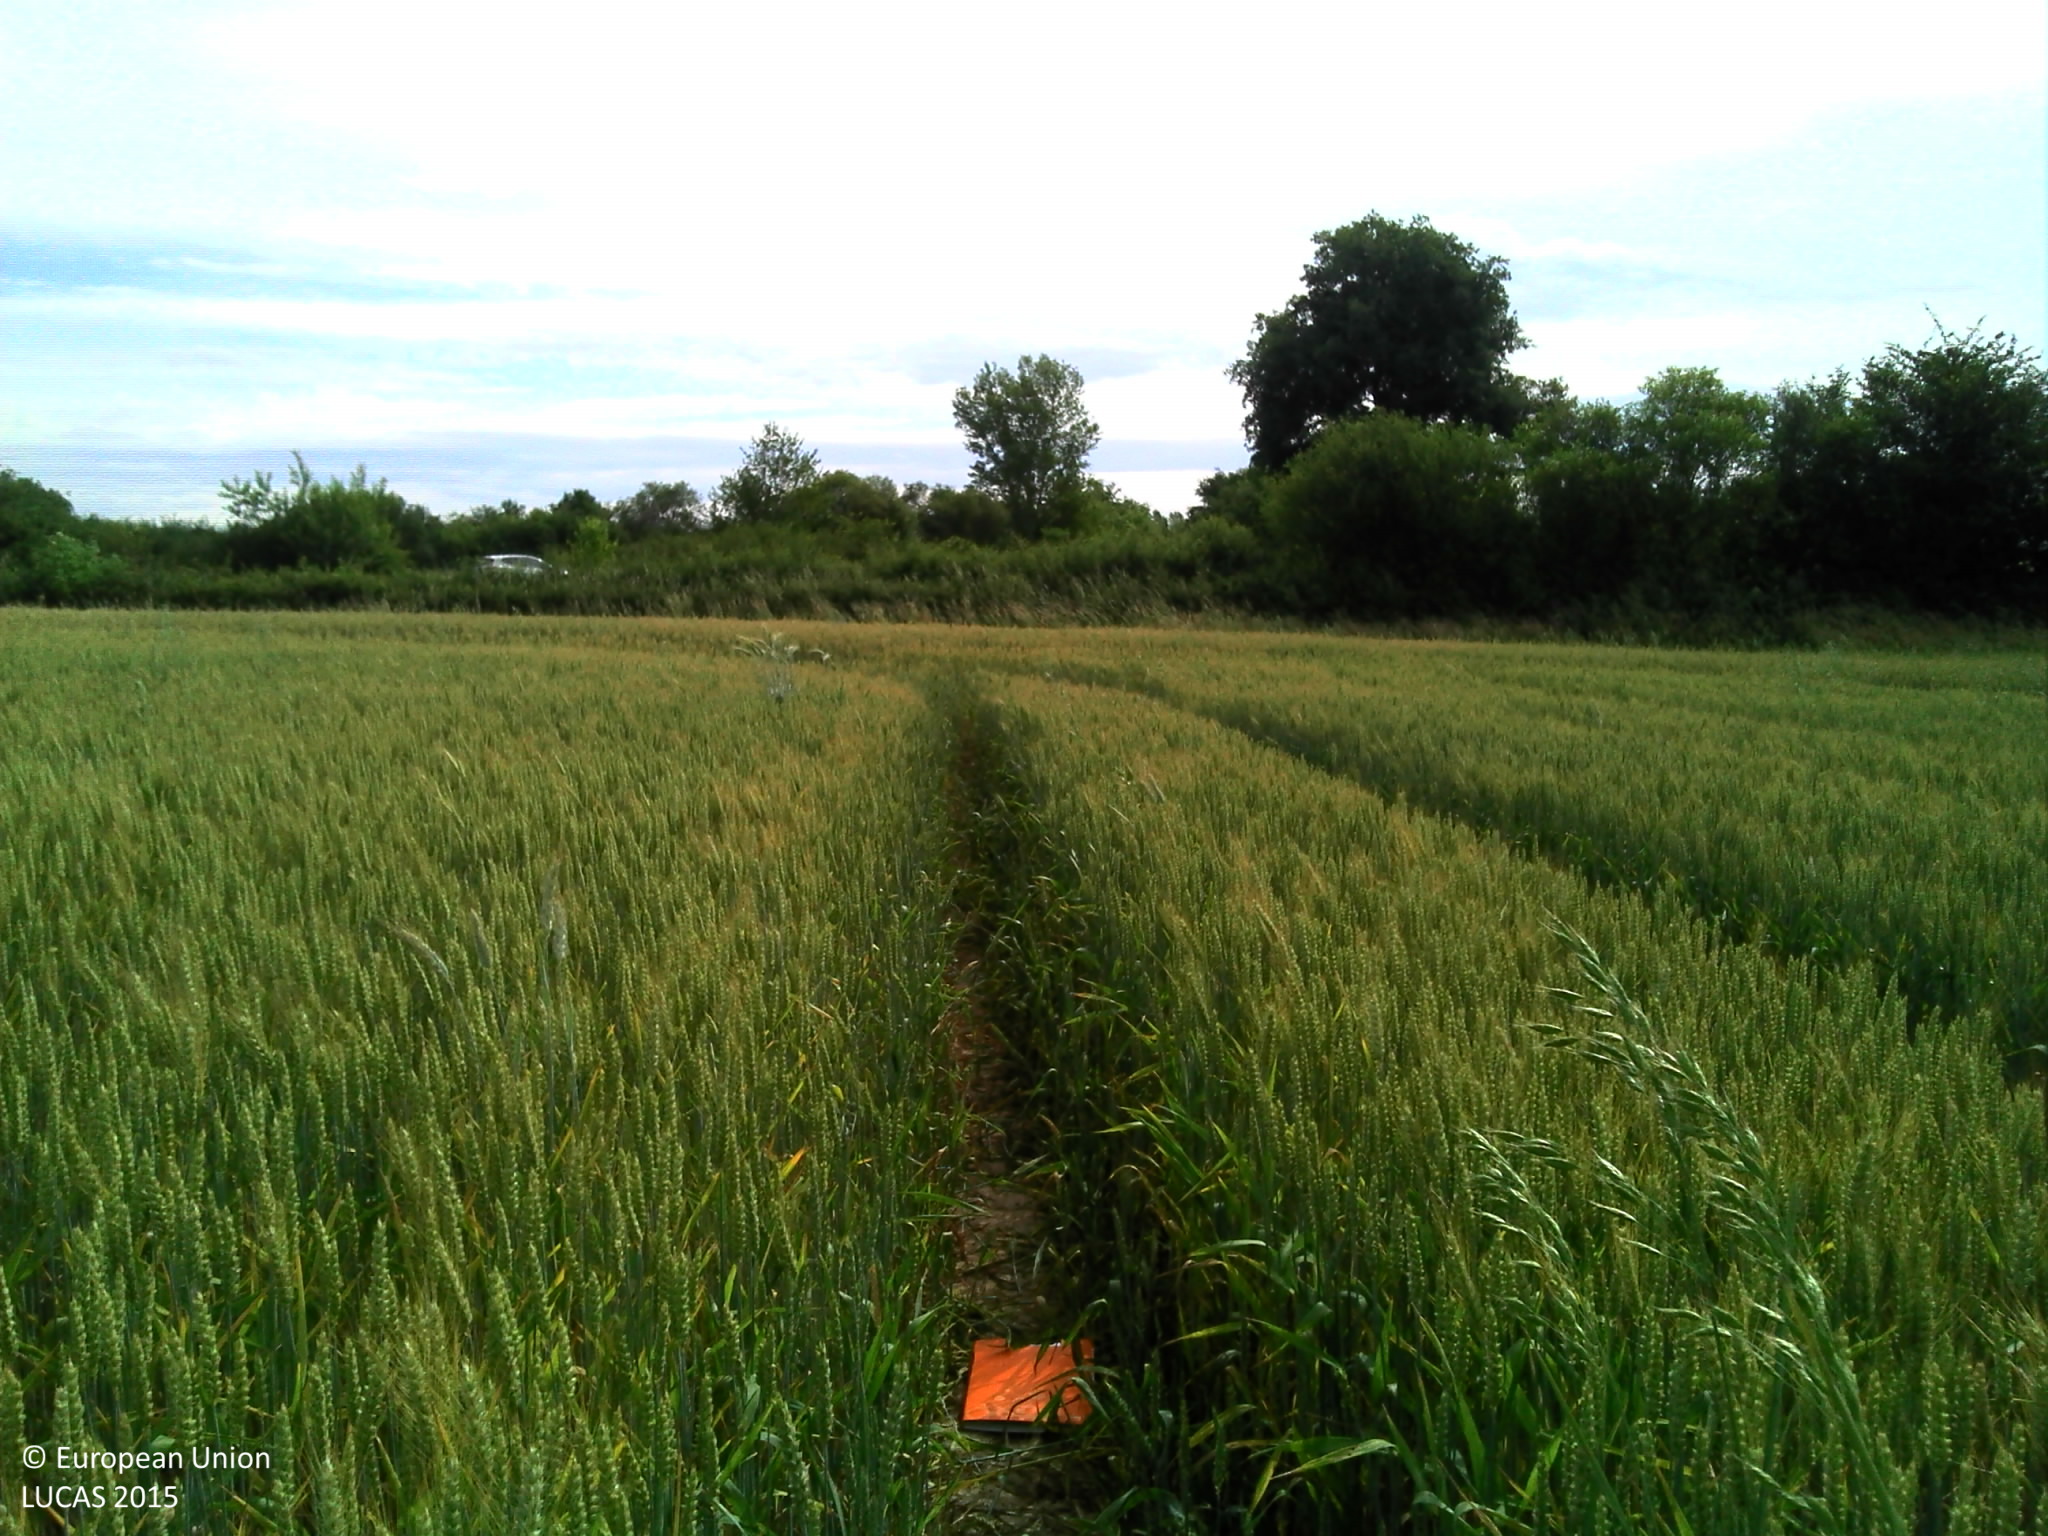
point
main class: Cropland
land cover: Common wheat
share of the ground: > 75 %
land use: Agriculture (excluding fallow land and kitchen gardens)
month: June
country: FR
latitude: 46.4626
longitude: 2.6910
